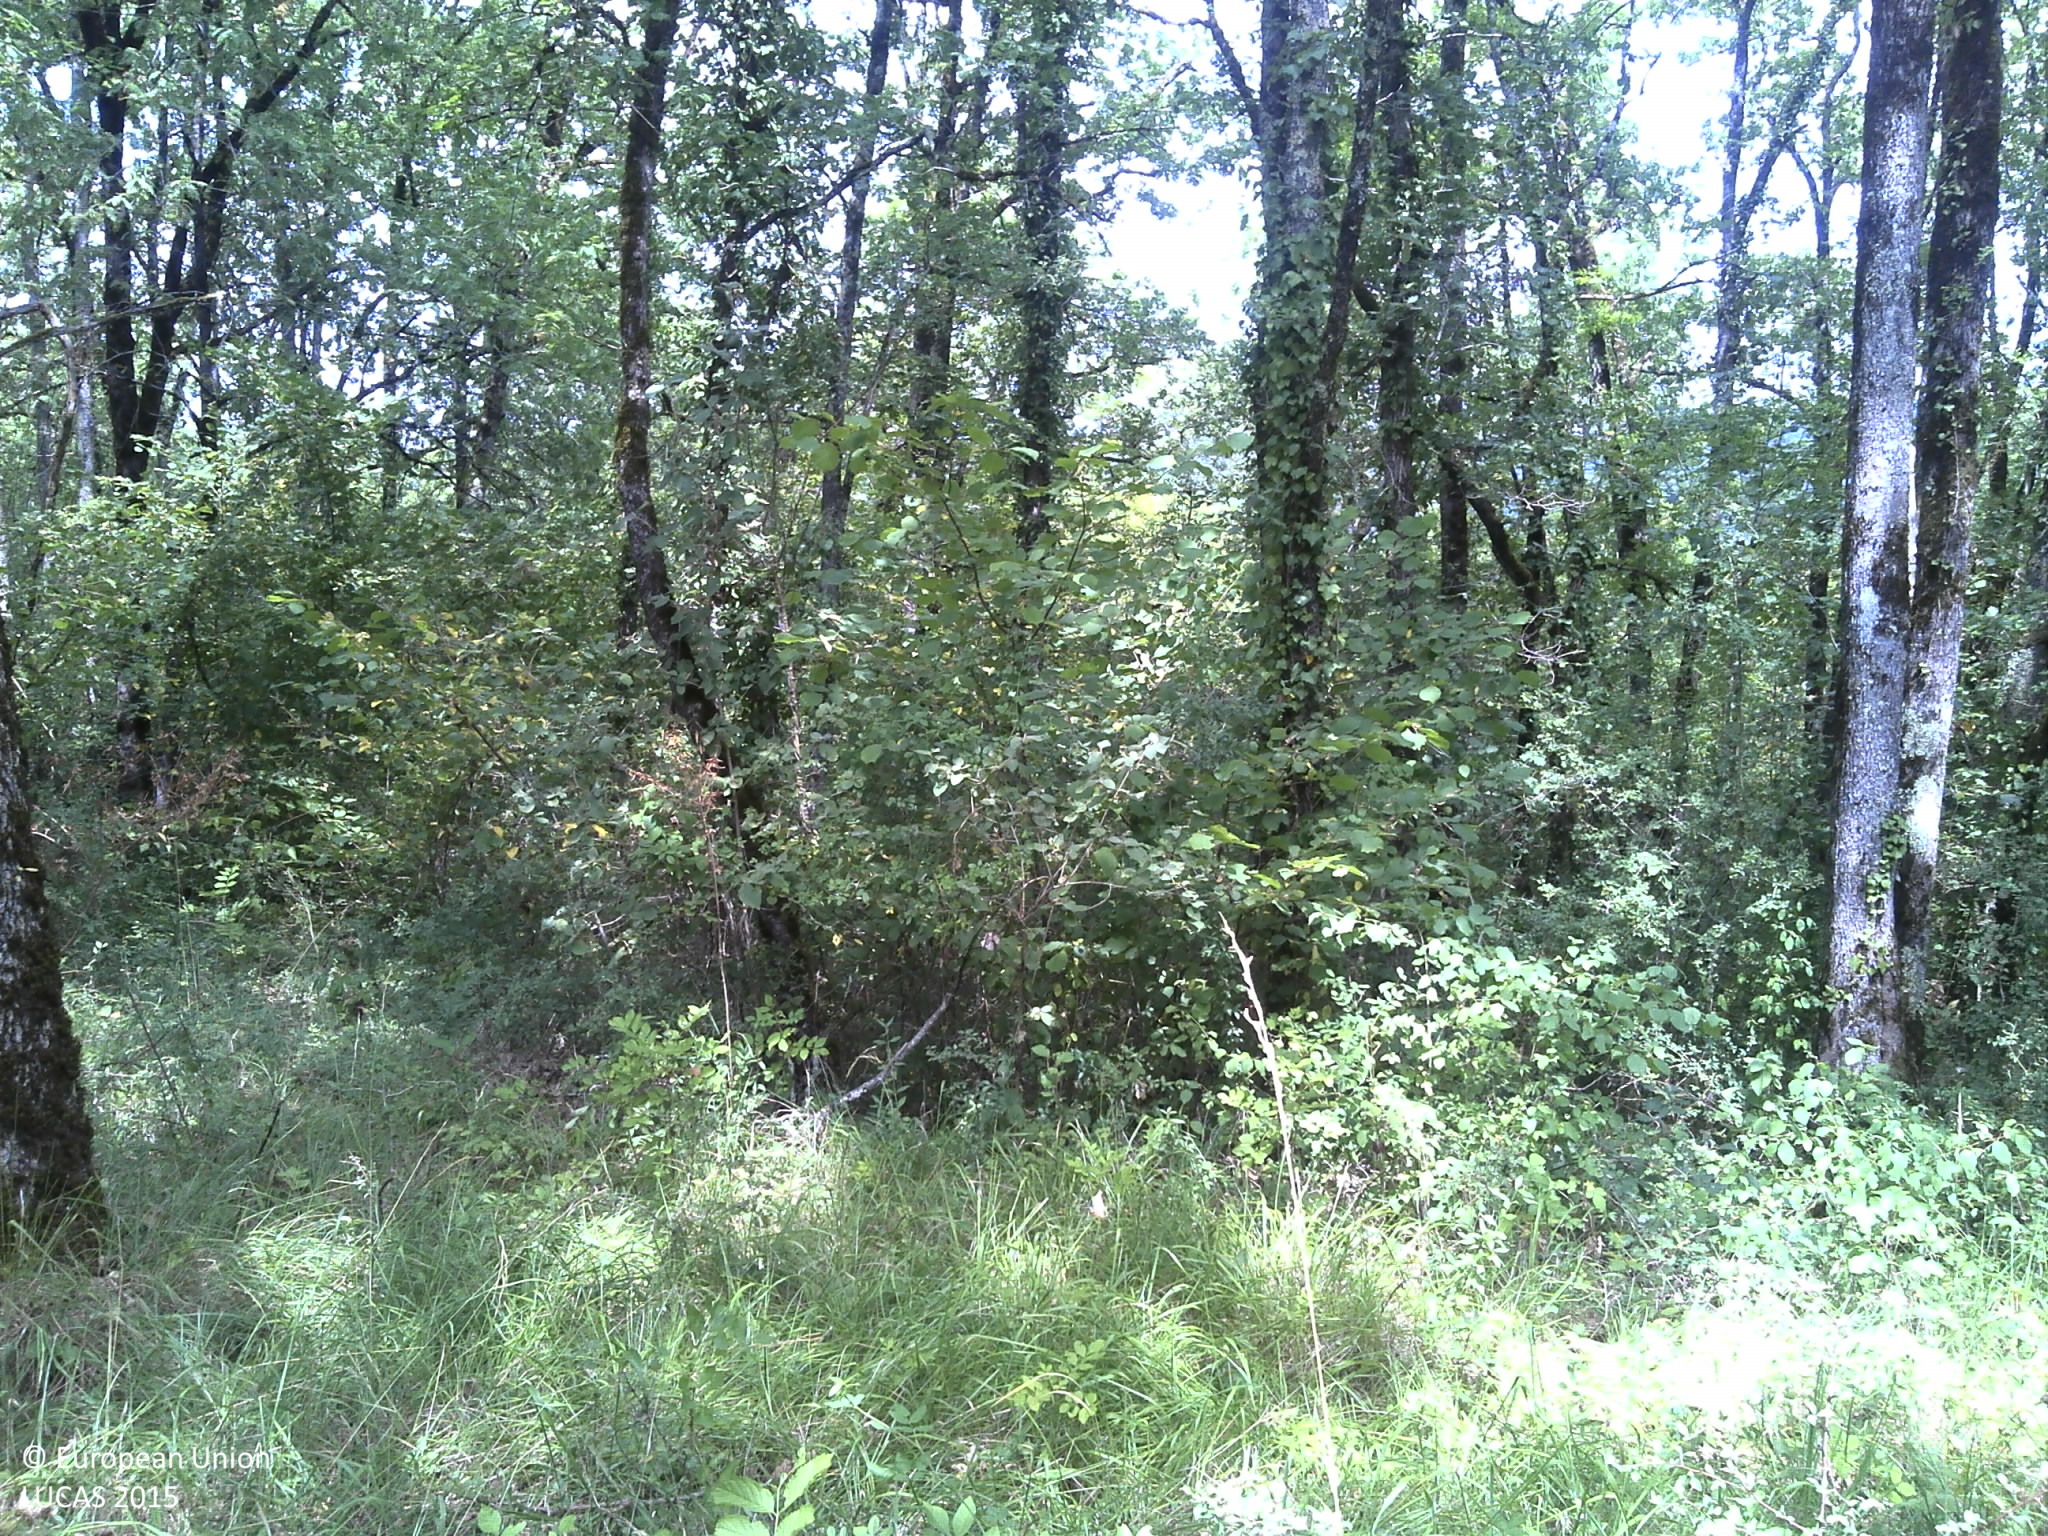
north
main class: Woodland
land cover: Broadleaved woodland
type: mesophytic deciduous forest
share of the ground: 50 - 75 %
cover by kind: broadleaved forest trees 55 %, herbaceous plants 35 %, shrubs 5 %, lichens and mosses 5 %
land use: Forestry
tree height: > 5 m
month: July
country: FR
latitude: 44.9474
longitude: 1.7719
